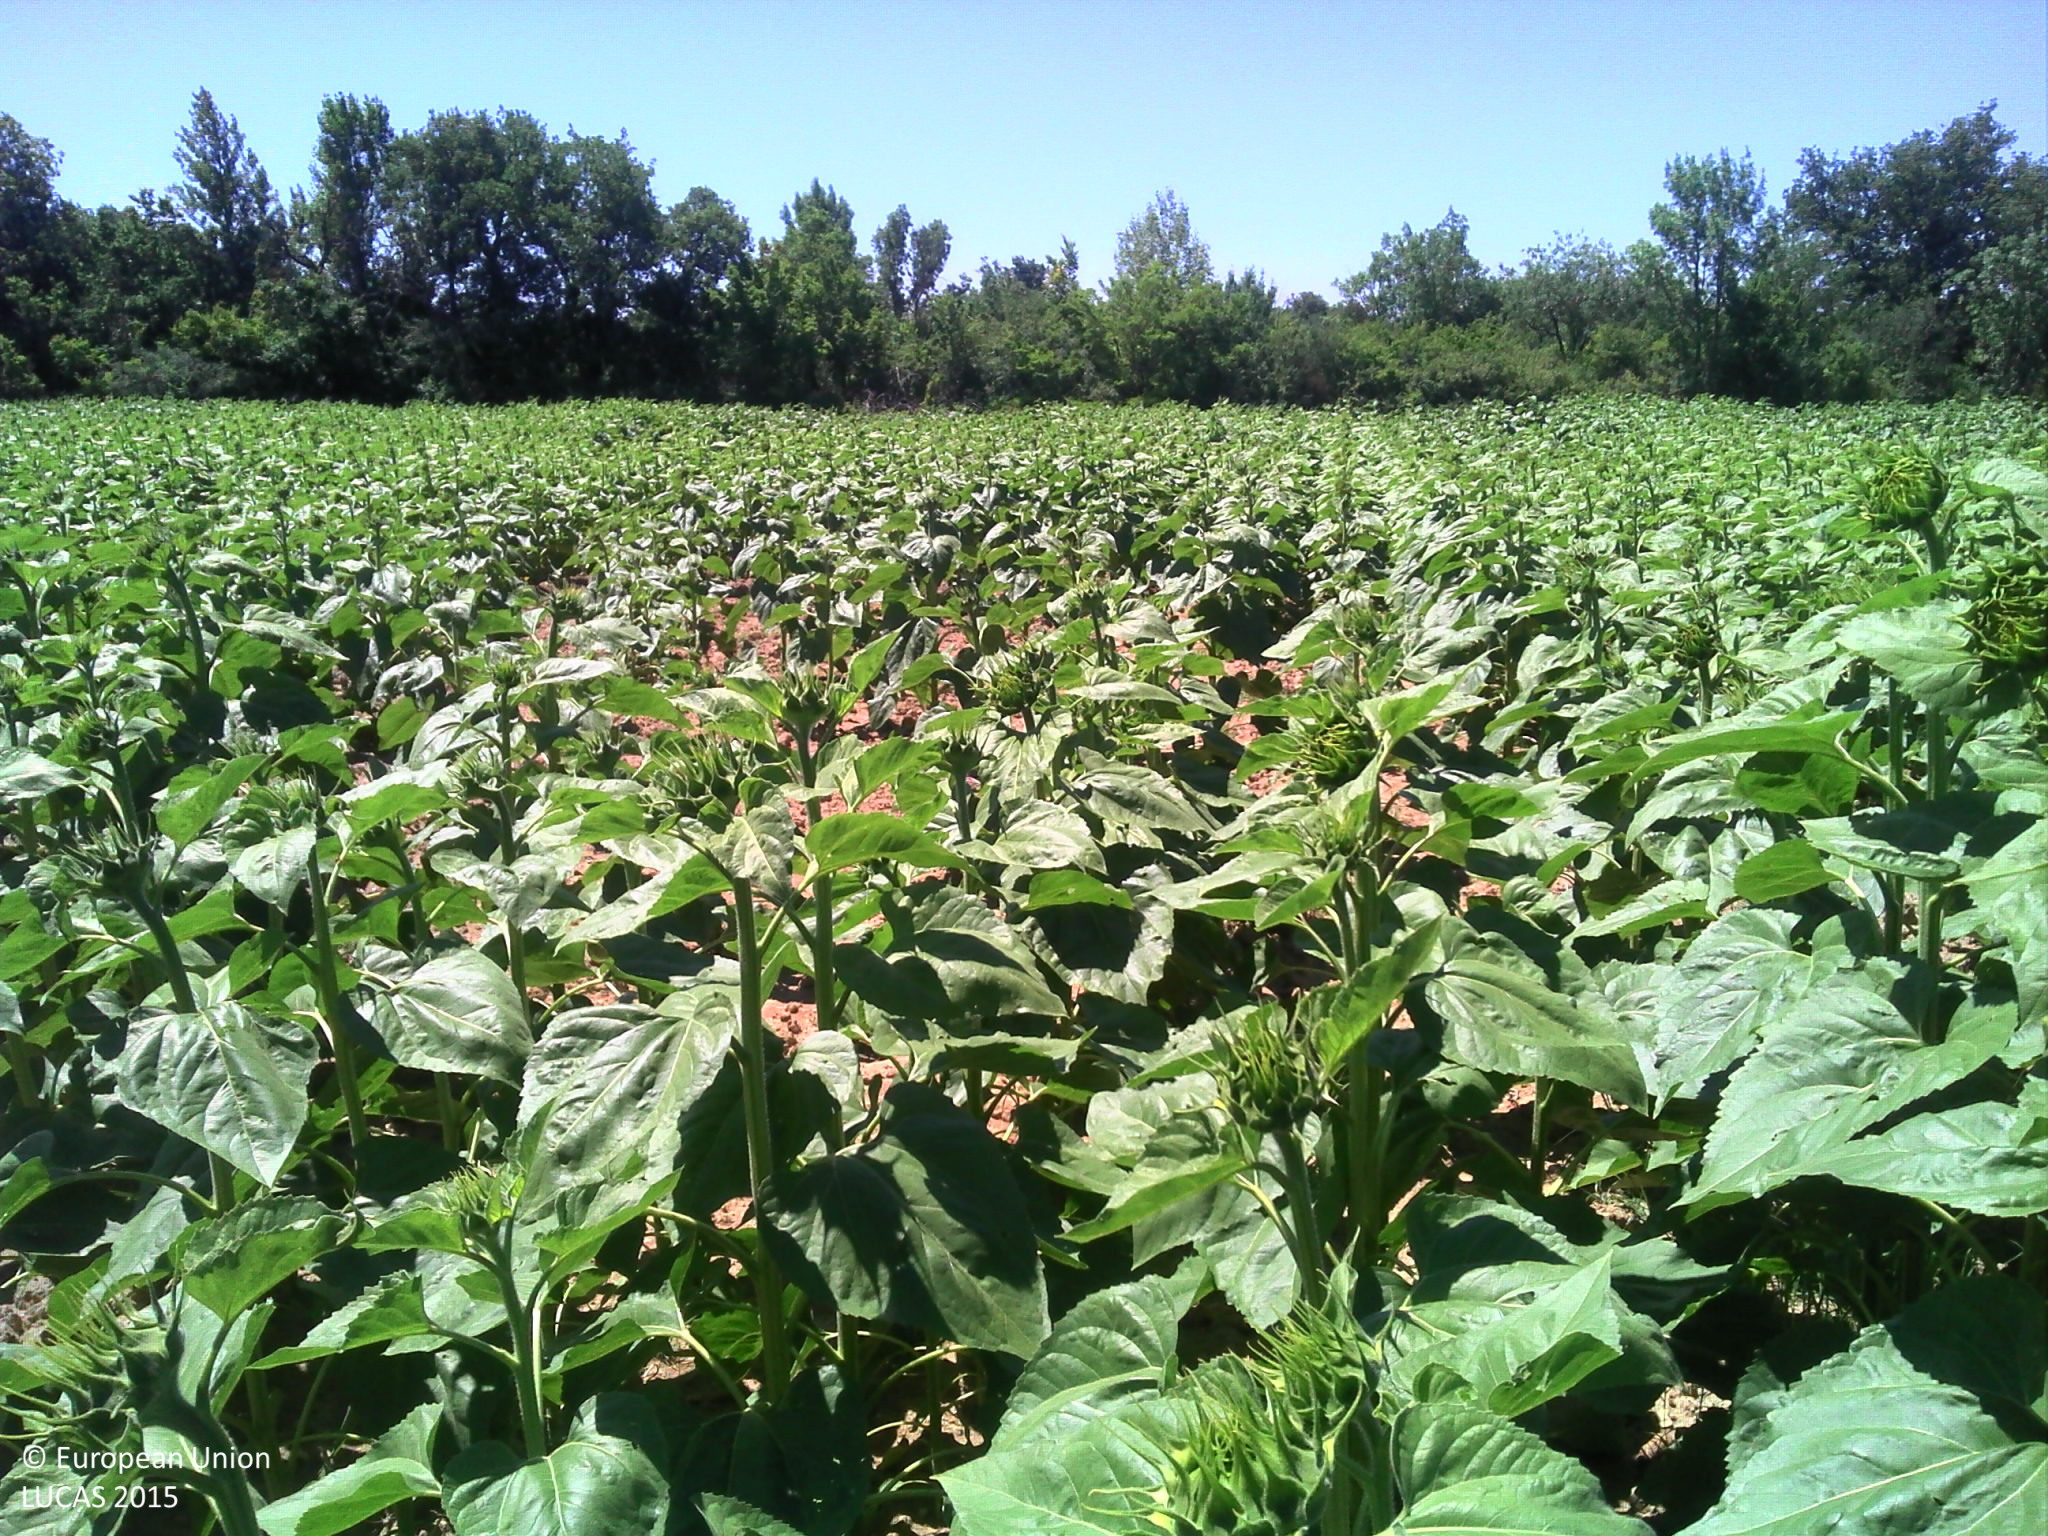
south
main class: Cropland
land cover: Sunflower
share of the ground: 50 - 75 %
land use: Agriculture (excluding fallow land and kitchen gardens)
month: June
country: FR
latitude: 43.3187
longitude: 2.0286
